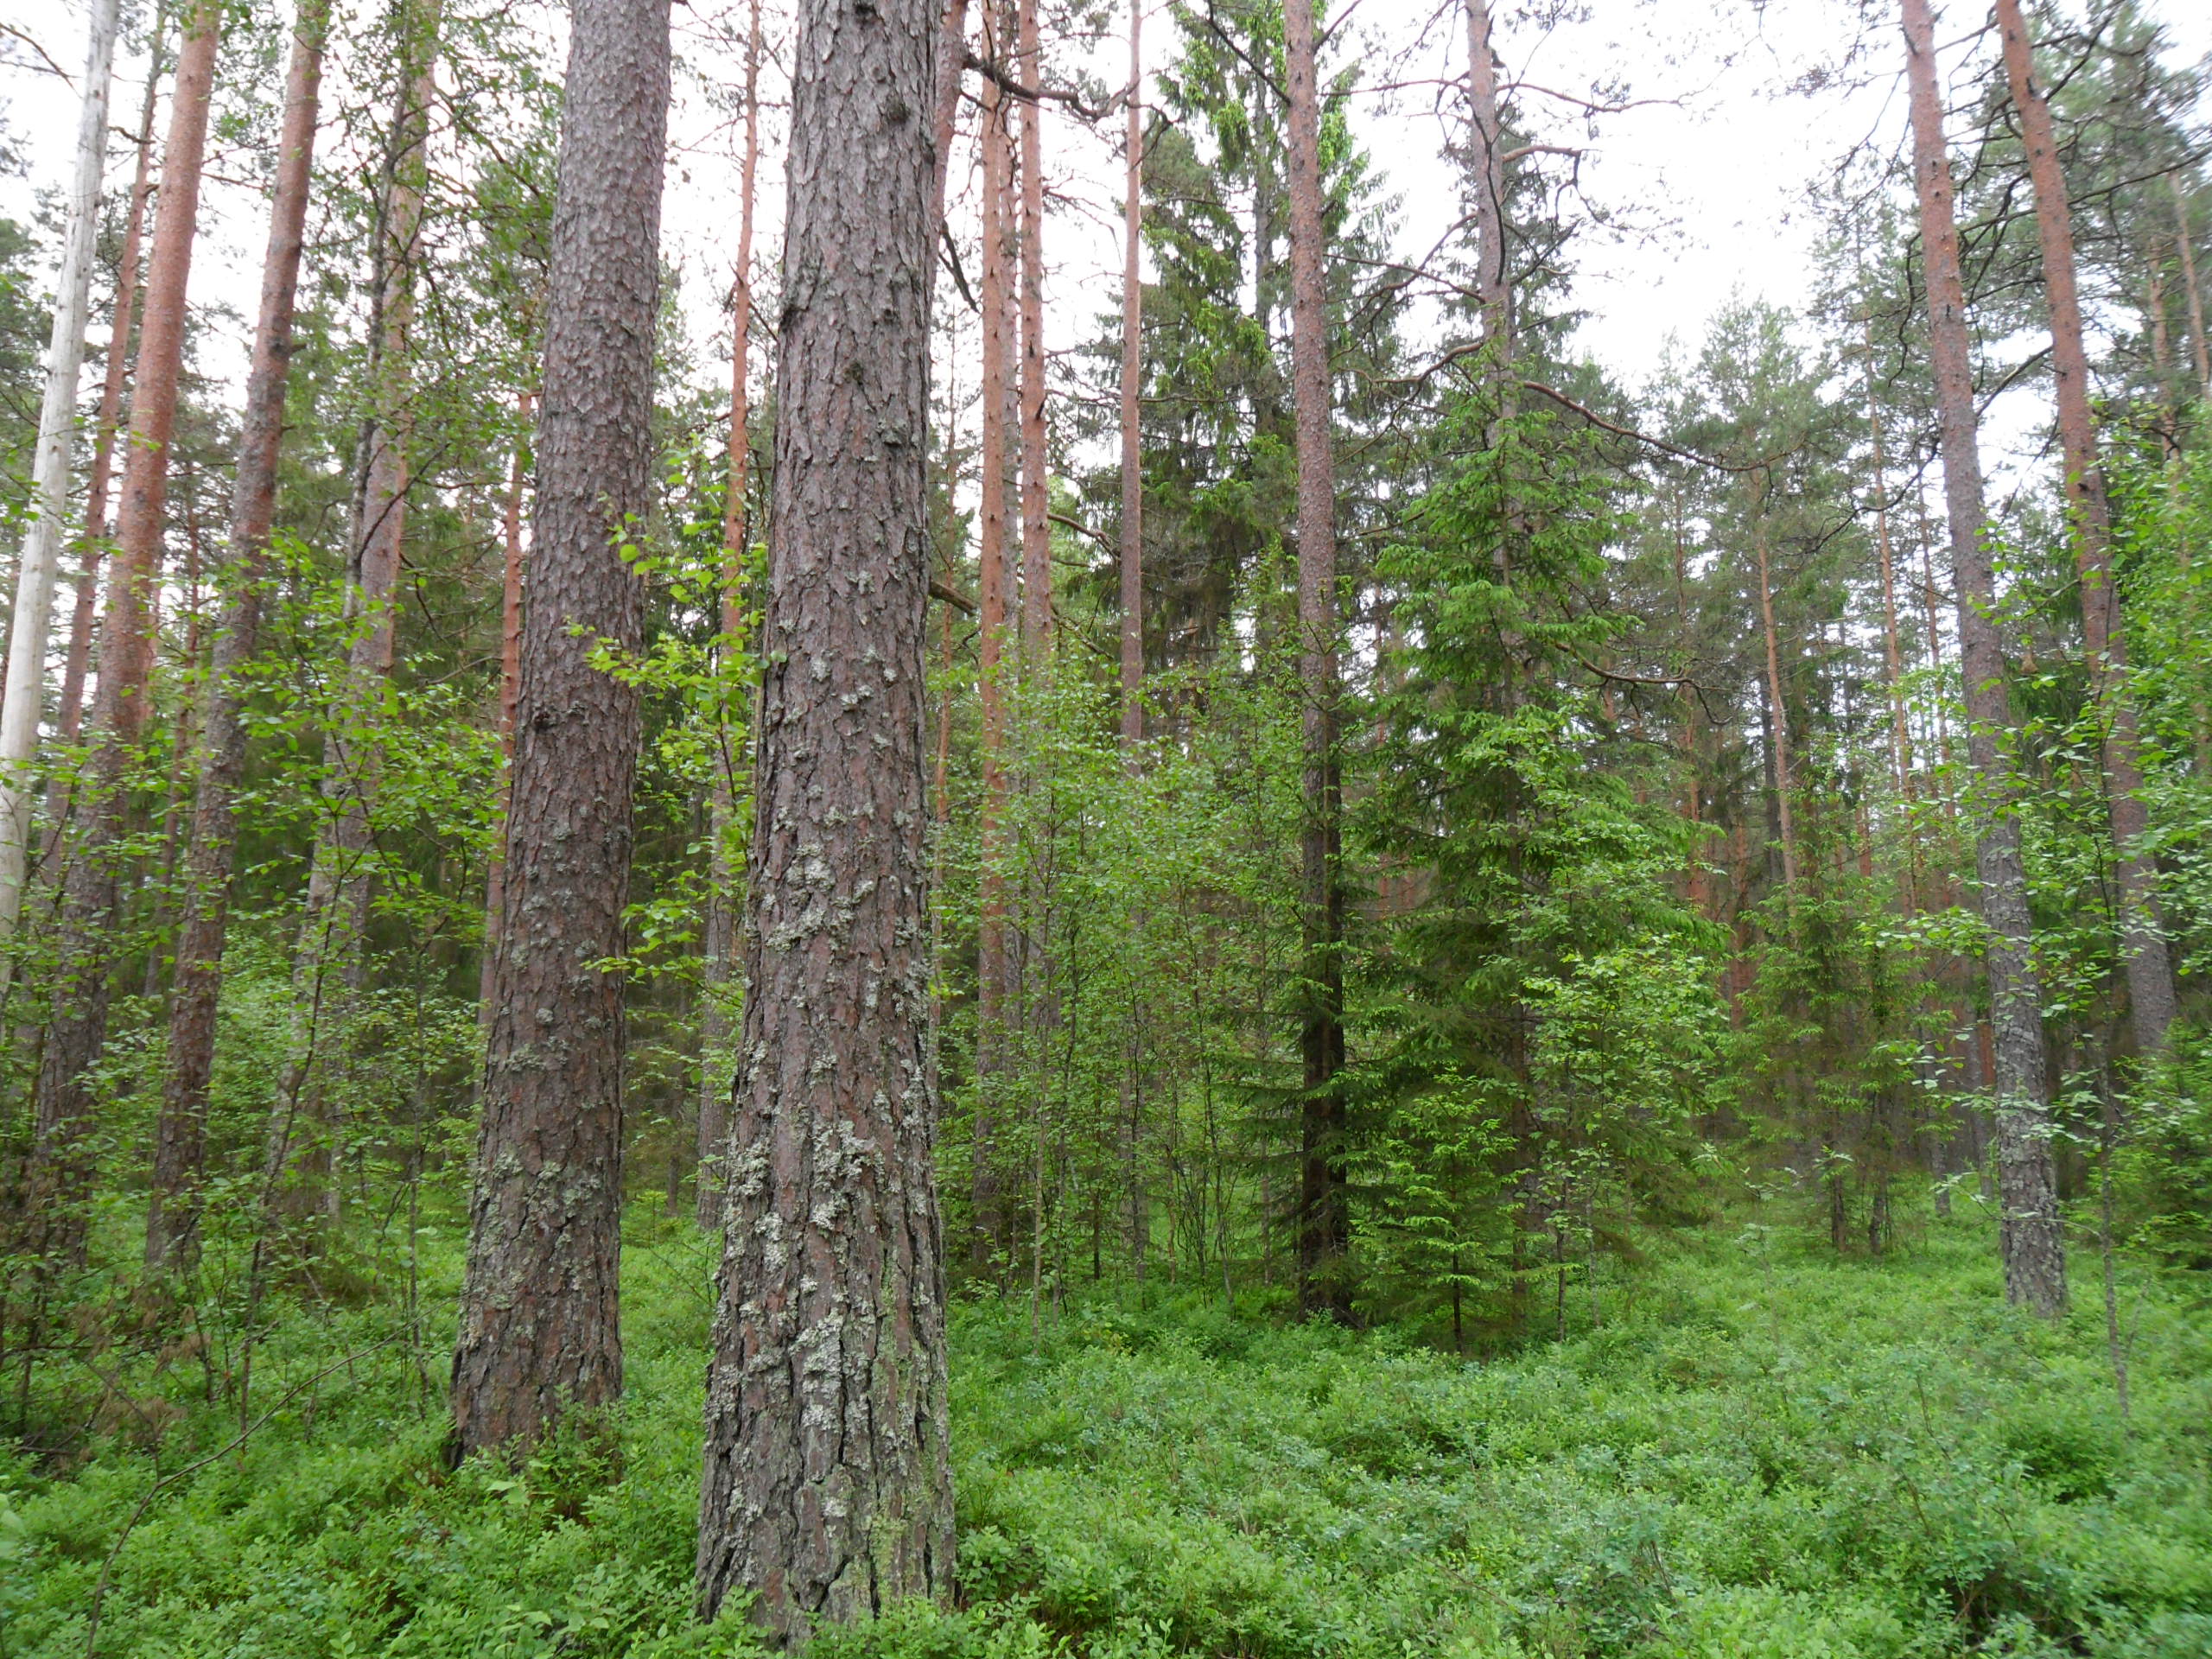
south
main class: Woodland
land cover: Other mixed woodland
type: hemiboreal forest and nemoral coniferous forest and mixed broadleaved-coniferous forest
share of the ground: 50 - 75 %
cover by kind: coniferous forest trees 40 %, broadleaved forest trees 30 %, herbaceous plants 20 %, shrubs 10 %
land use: Forestry
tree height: > 5 m
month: June
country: LV
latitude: 57.2576
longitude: 22.0322
